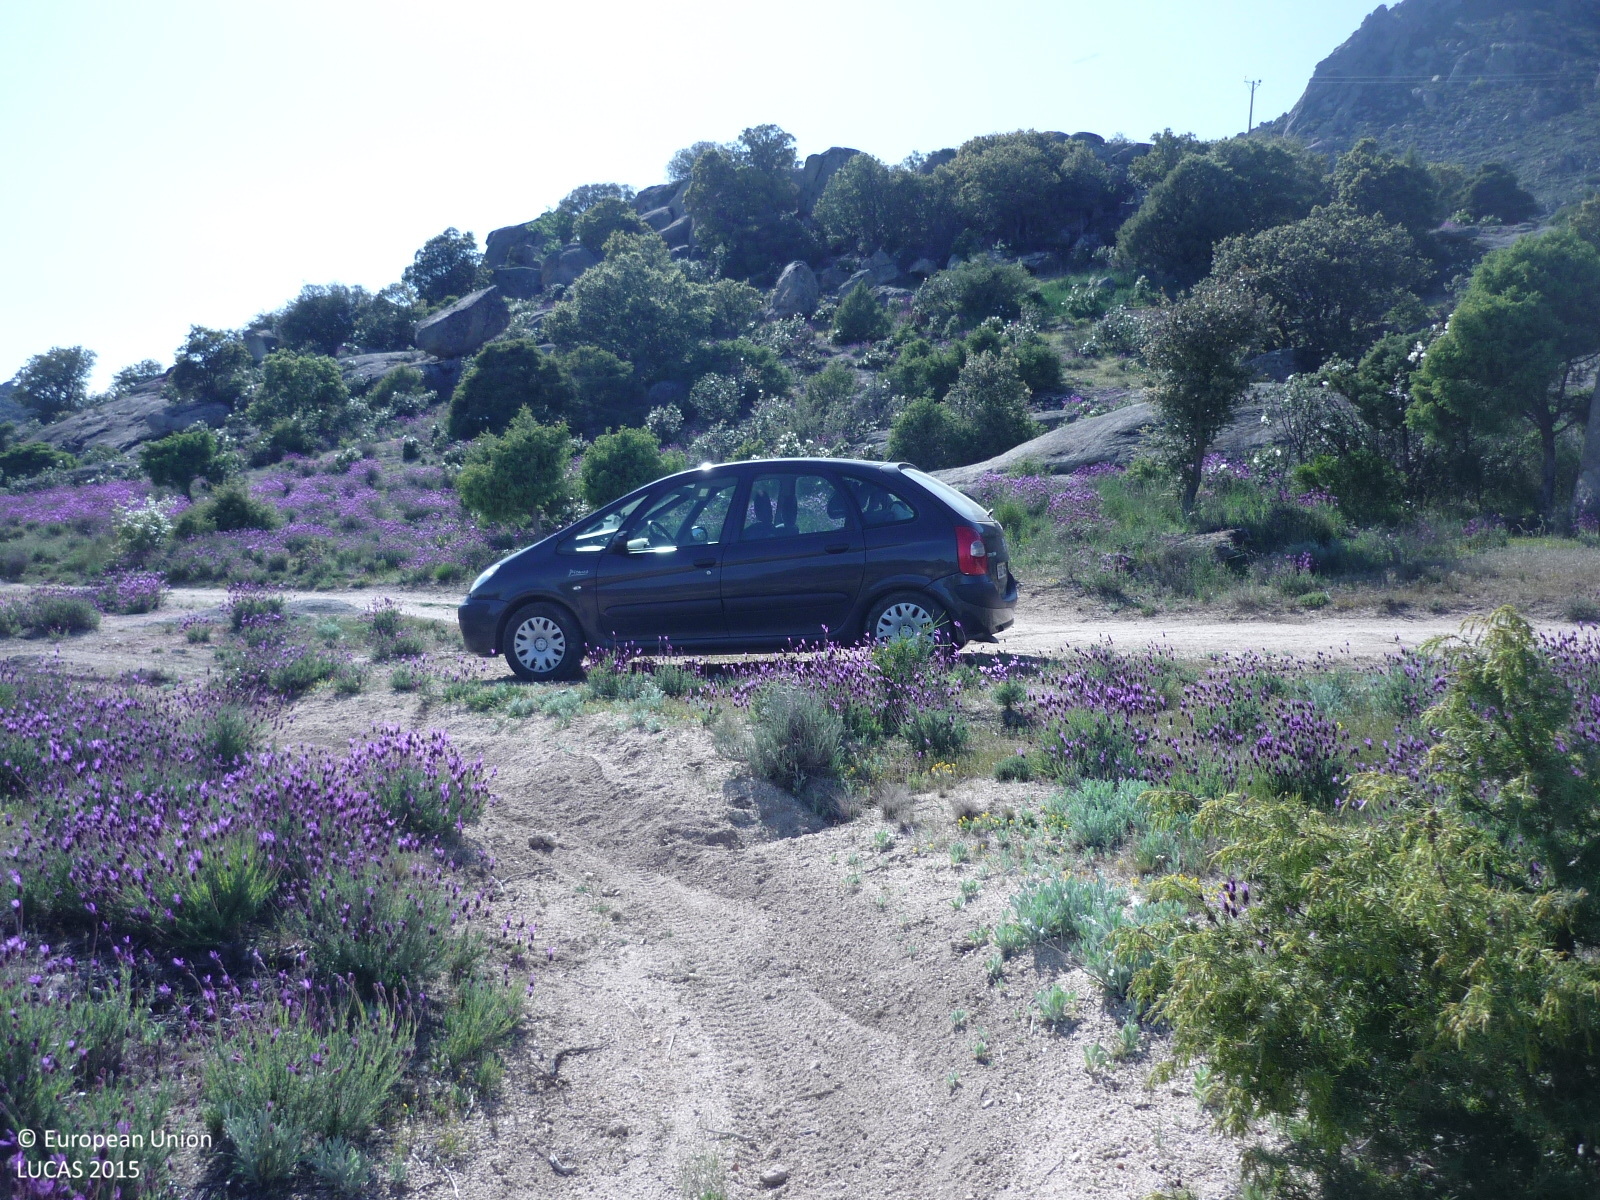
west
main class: Shrubland
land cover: Shrubland with sparse tree cover
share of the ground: > 75 %
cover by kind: shrubs 85 %, herbaceous plants 10 %, broadleaved forest trees 5 %
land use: Semi-natural and natural areas not in use
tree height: < 5 m
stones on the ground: < 10 %
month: May
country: ES
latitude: 40.8682
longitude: -3.6275
